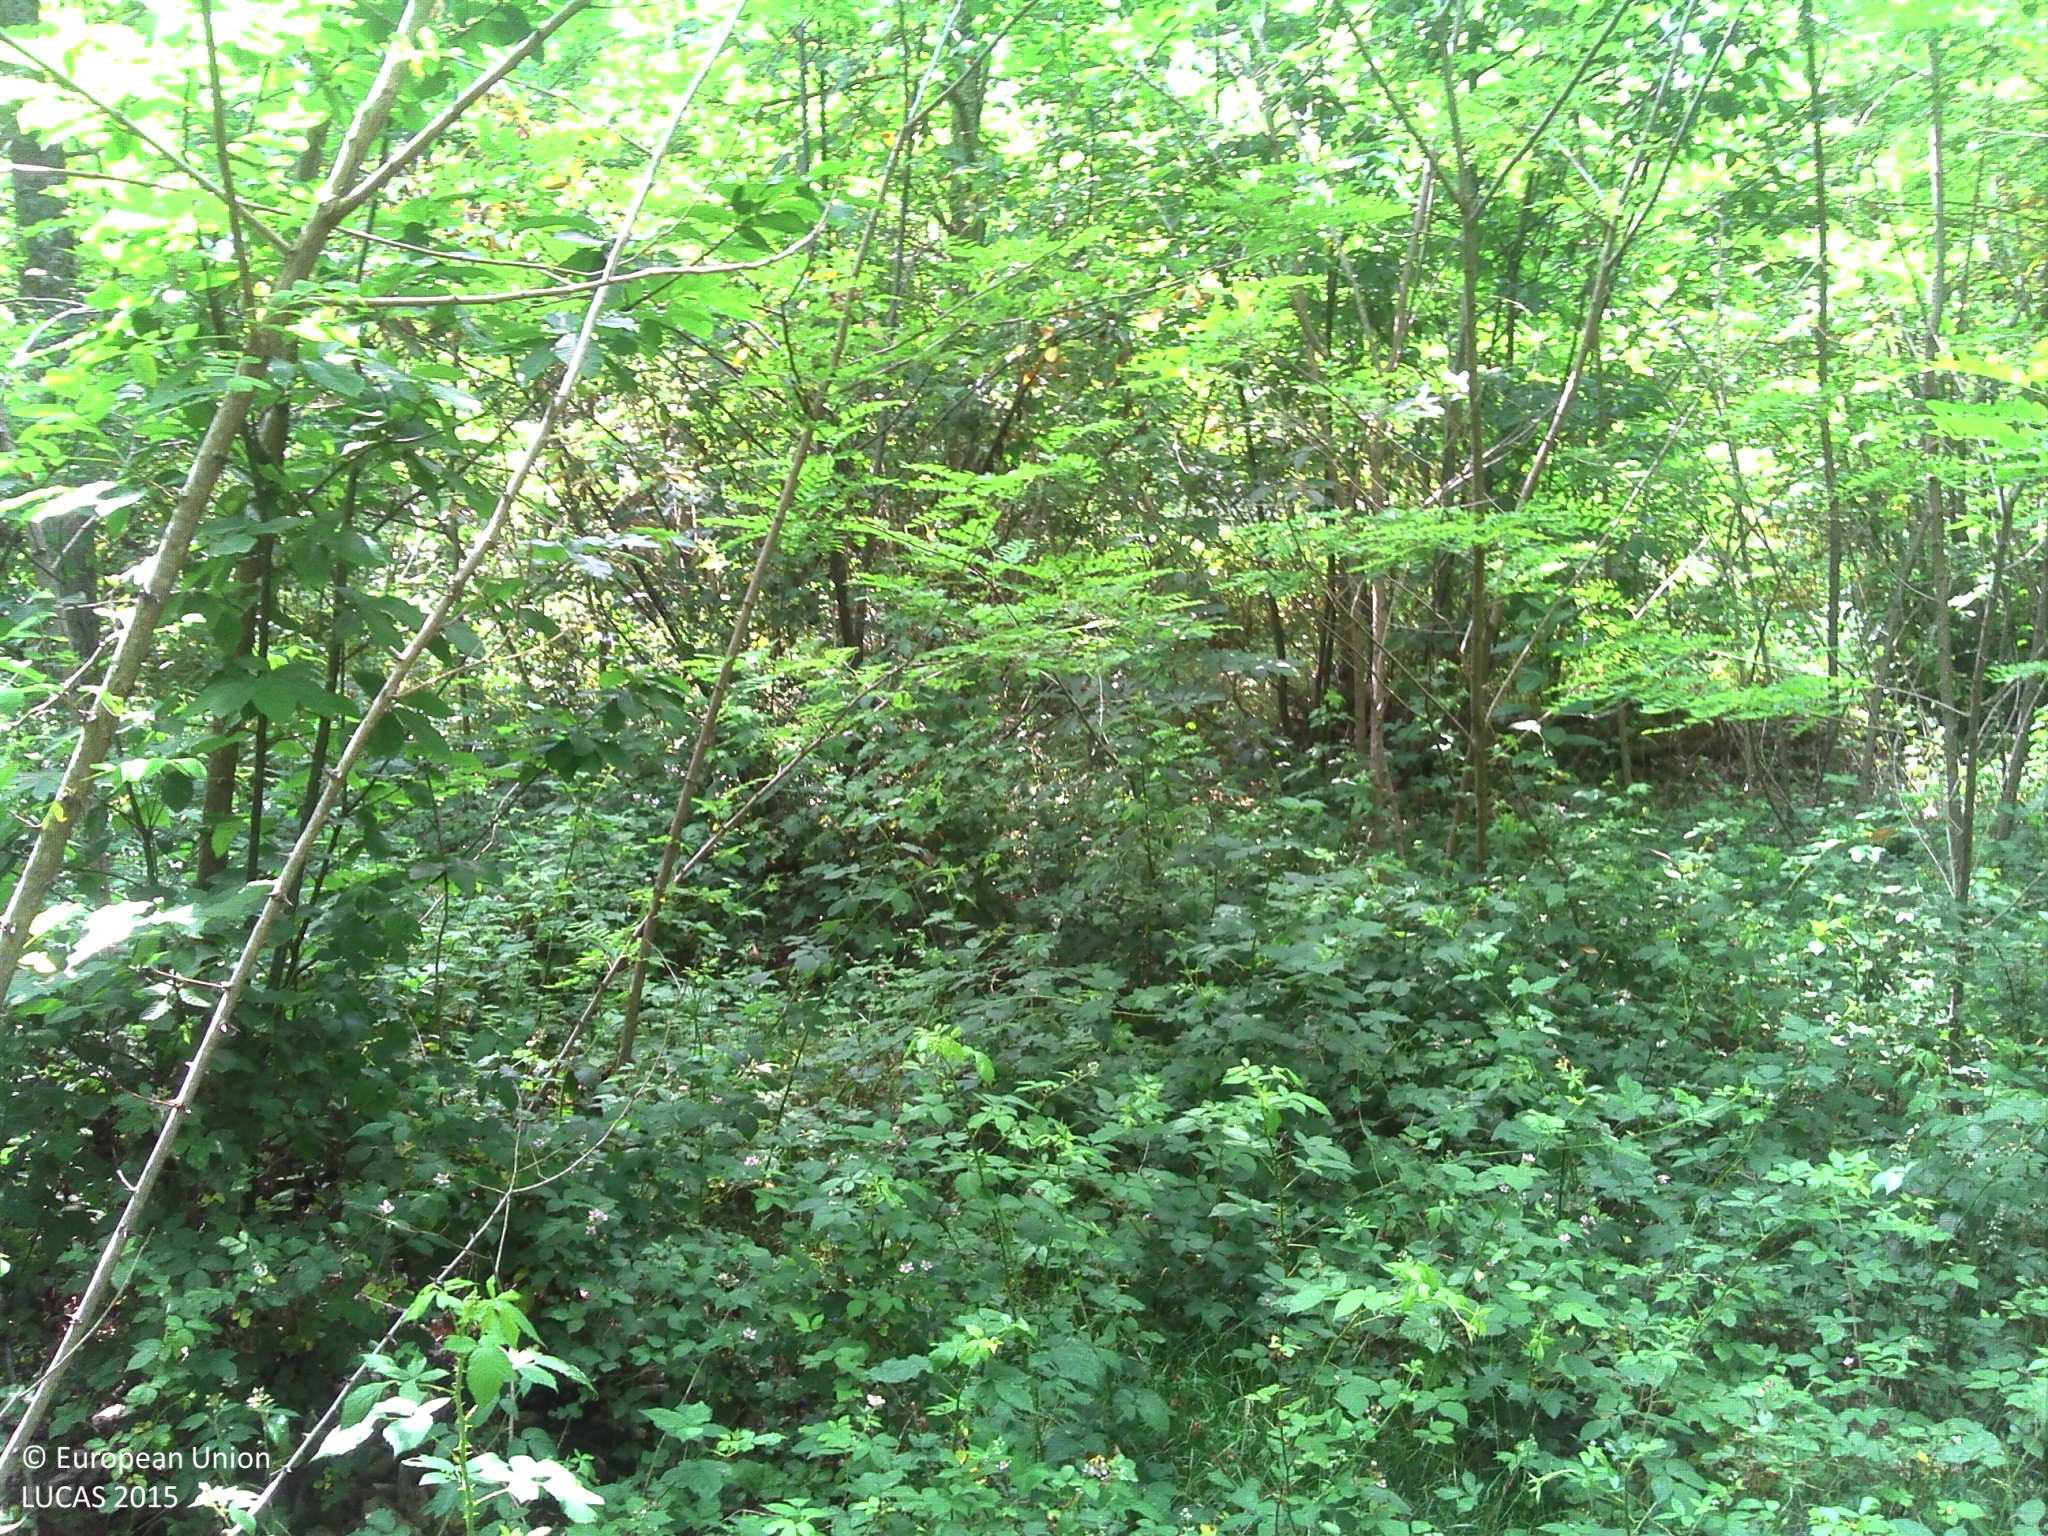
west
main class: Woodland
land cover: Broadleaved woodland
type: mesophytic deciduous forest
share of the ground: > 75 %
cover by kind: herbaceous plants 50 %, broadleaved forest trees 30 %, lichens and mosses 20 %
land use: Forestry
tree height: > 5 m
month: June
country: FR
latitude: 47.6264
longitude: 2.0180
